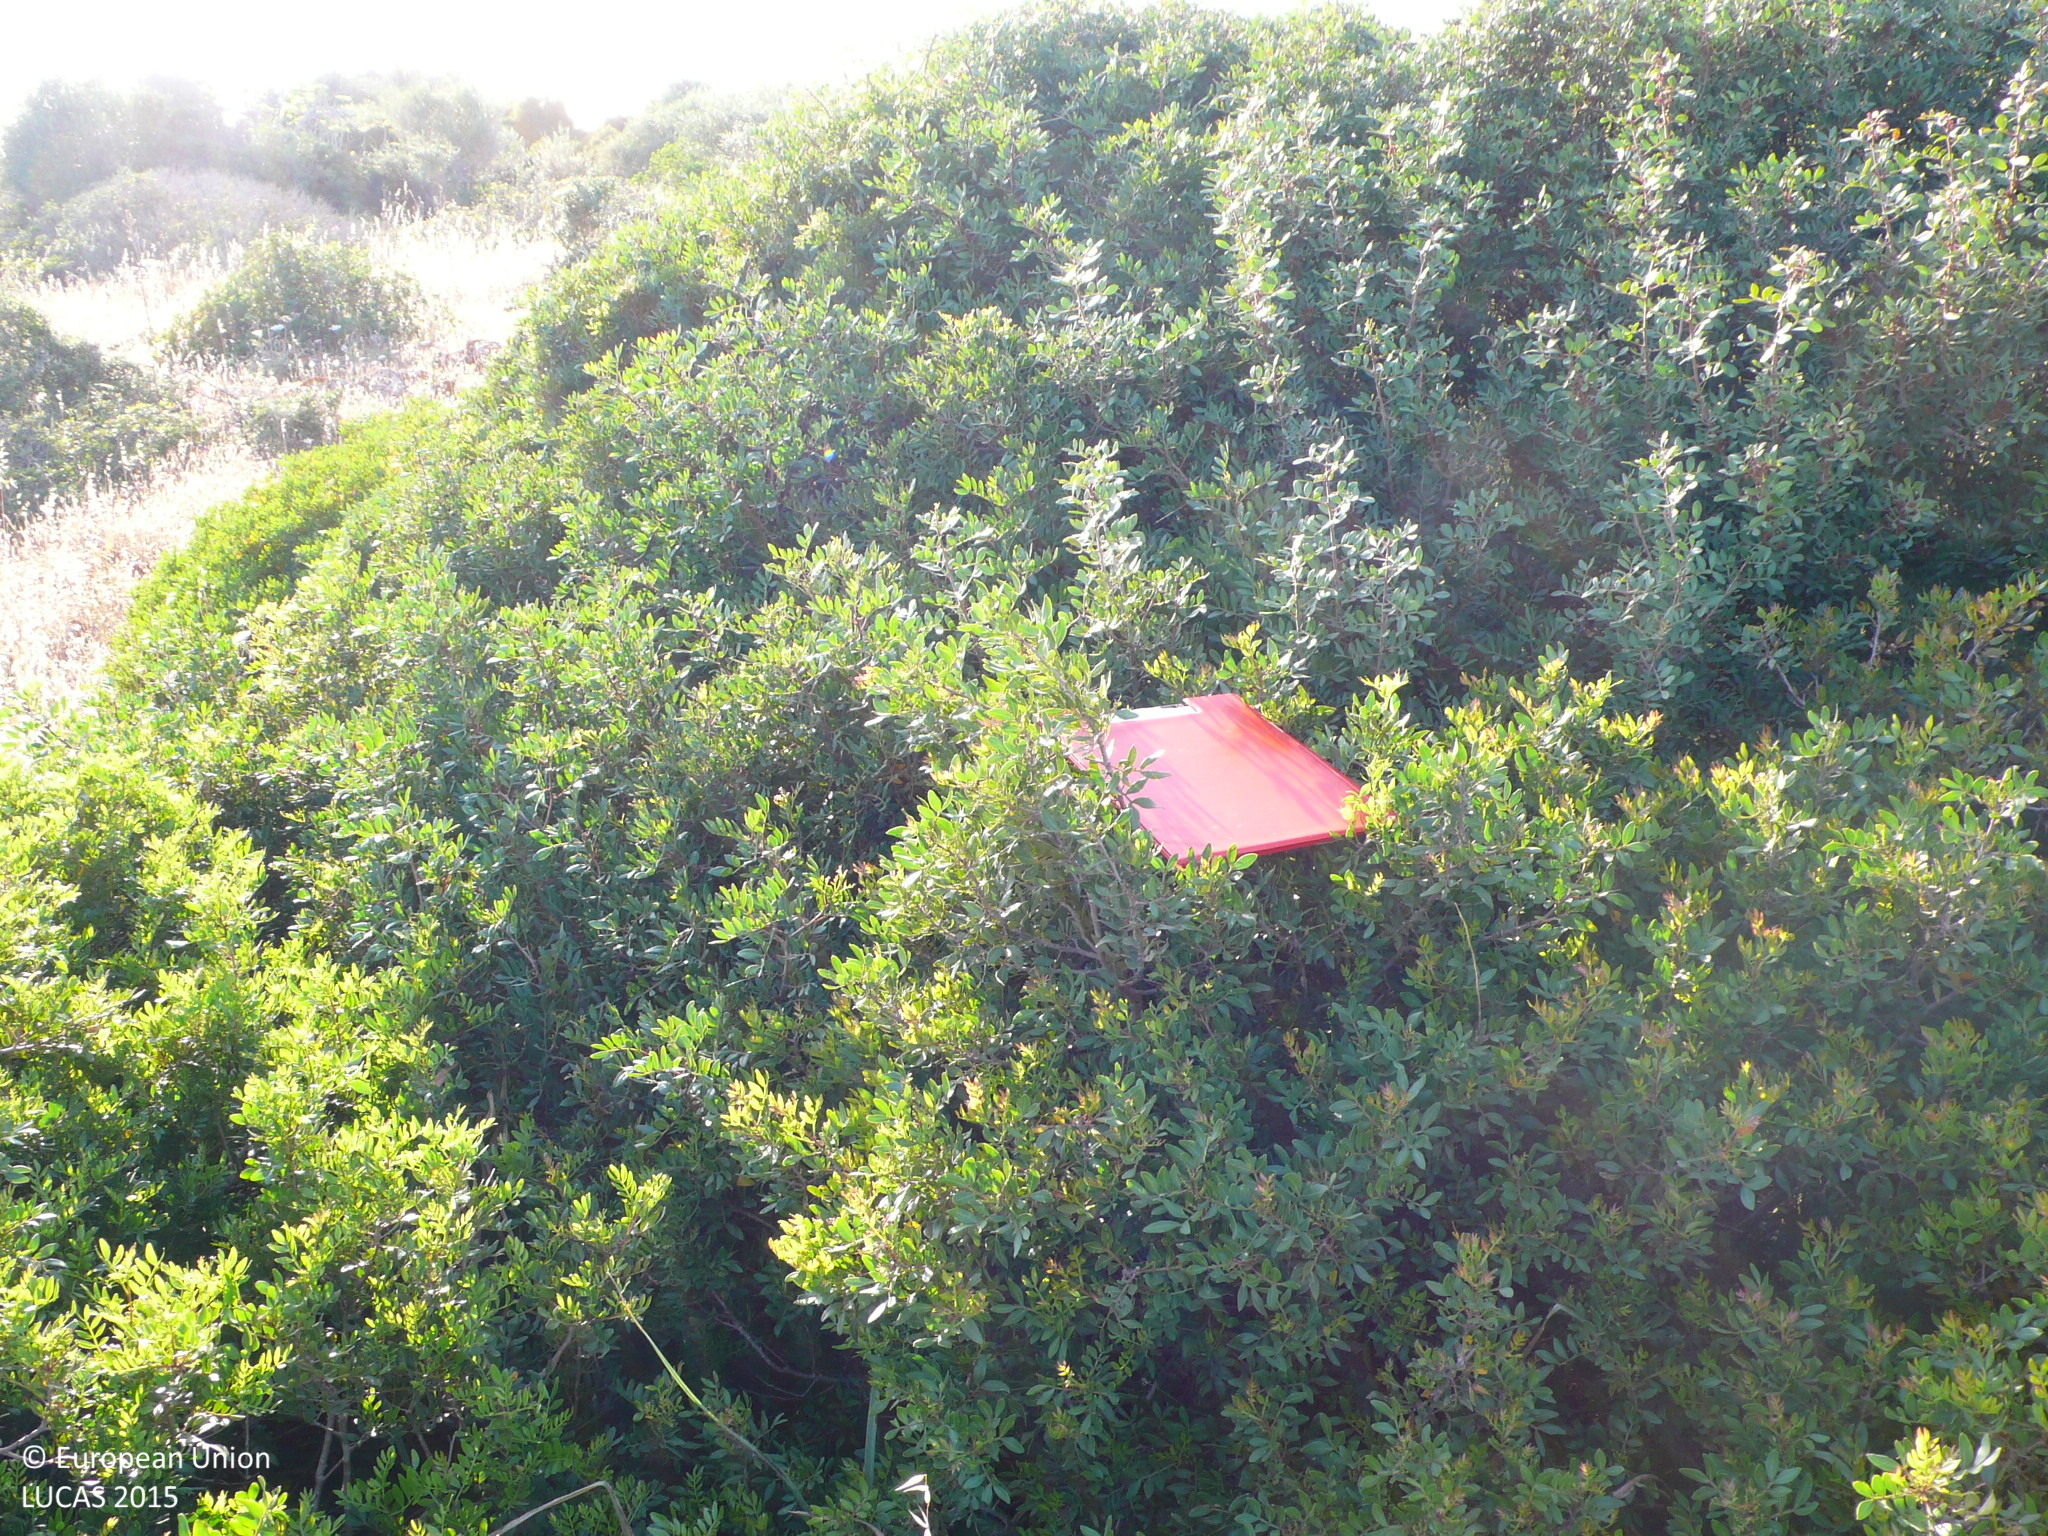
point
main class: Shrubland
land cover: Shrubland with sparse tree cover
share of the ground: 25 - 50 %
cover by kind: herbaceous plants 70 %, shrubs 25 %, broadleaved forest trees 5 %
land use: Semi-natural and natural areas not in use
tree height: < 5 m
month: May
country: ES
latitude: 39.8941
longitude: 4.1670
